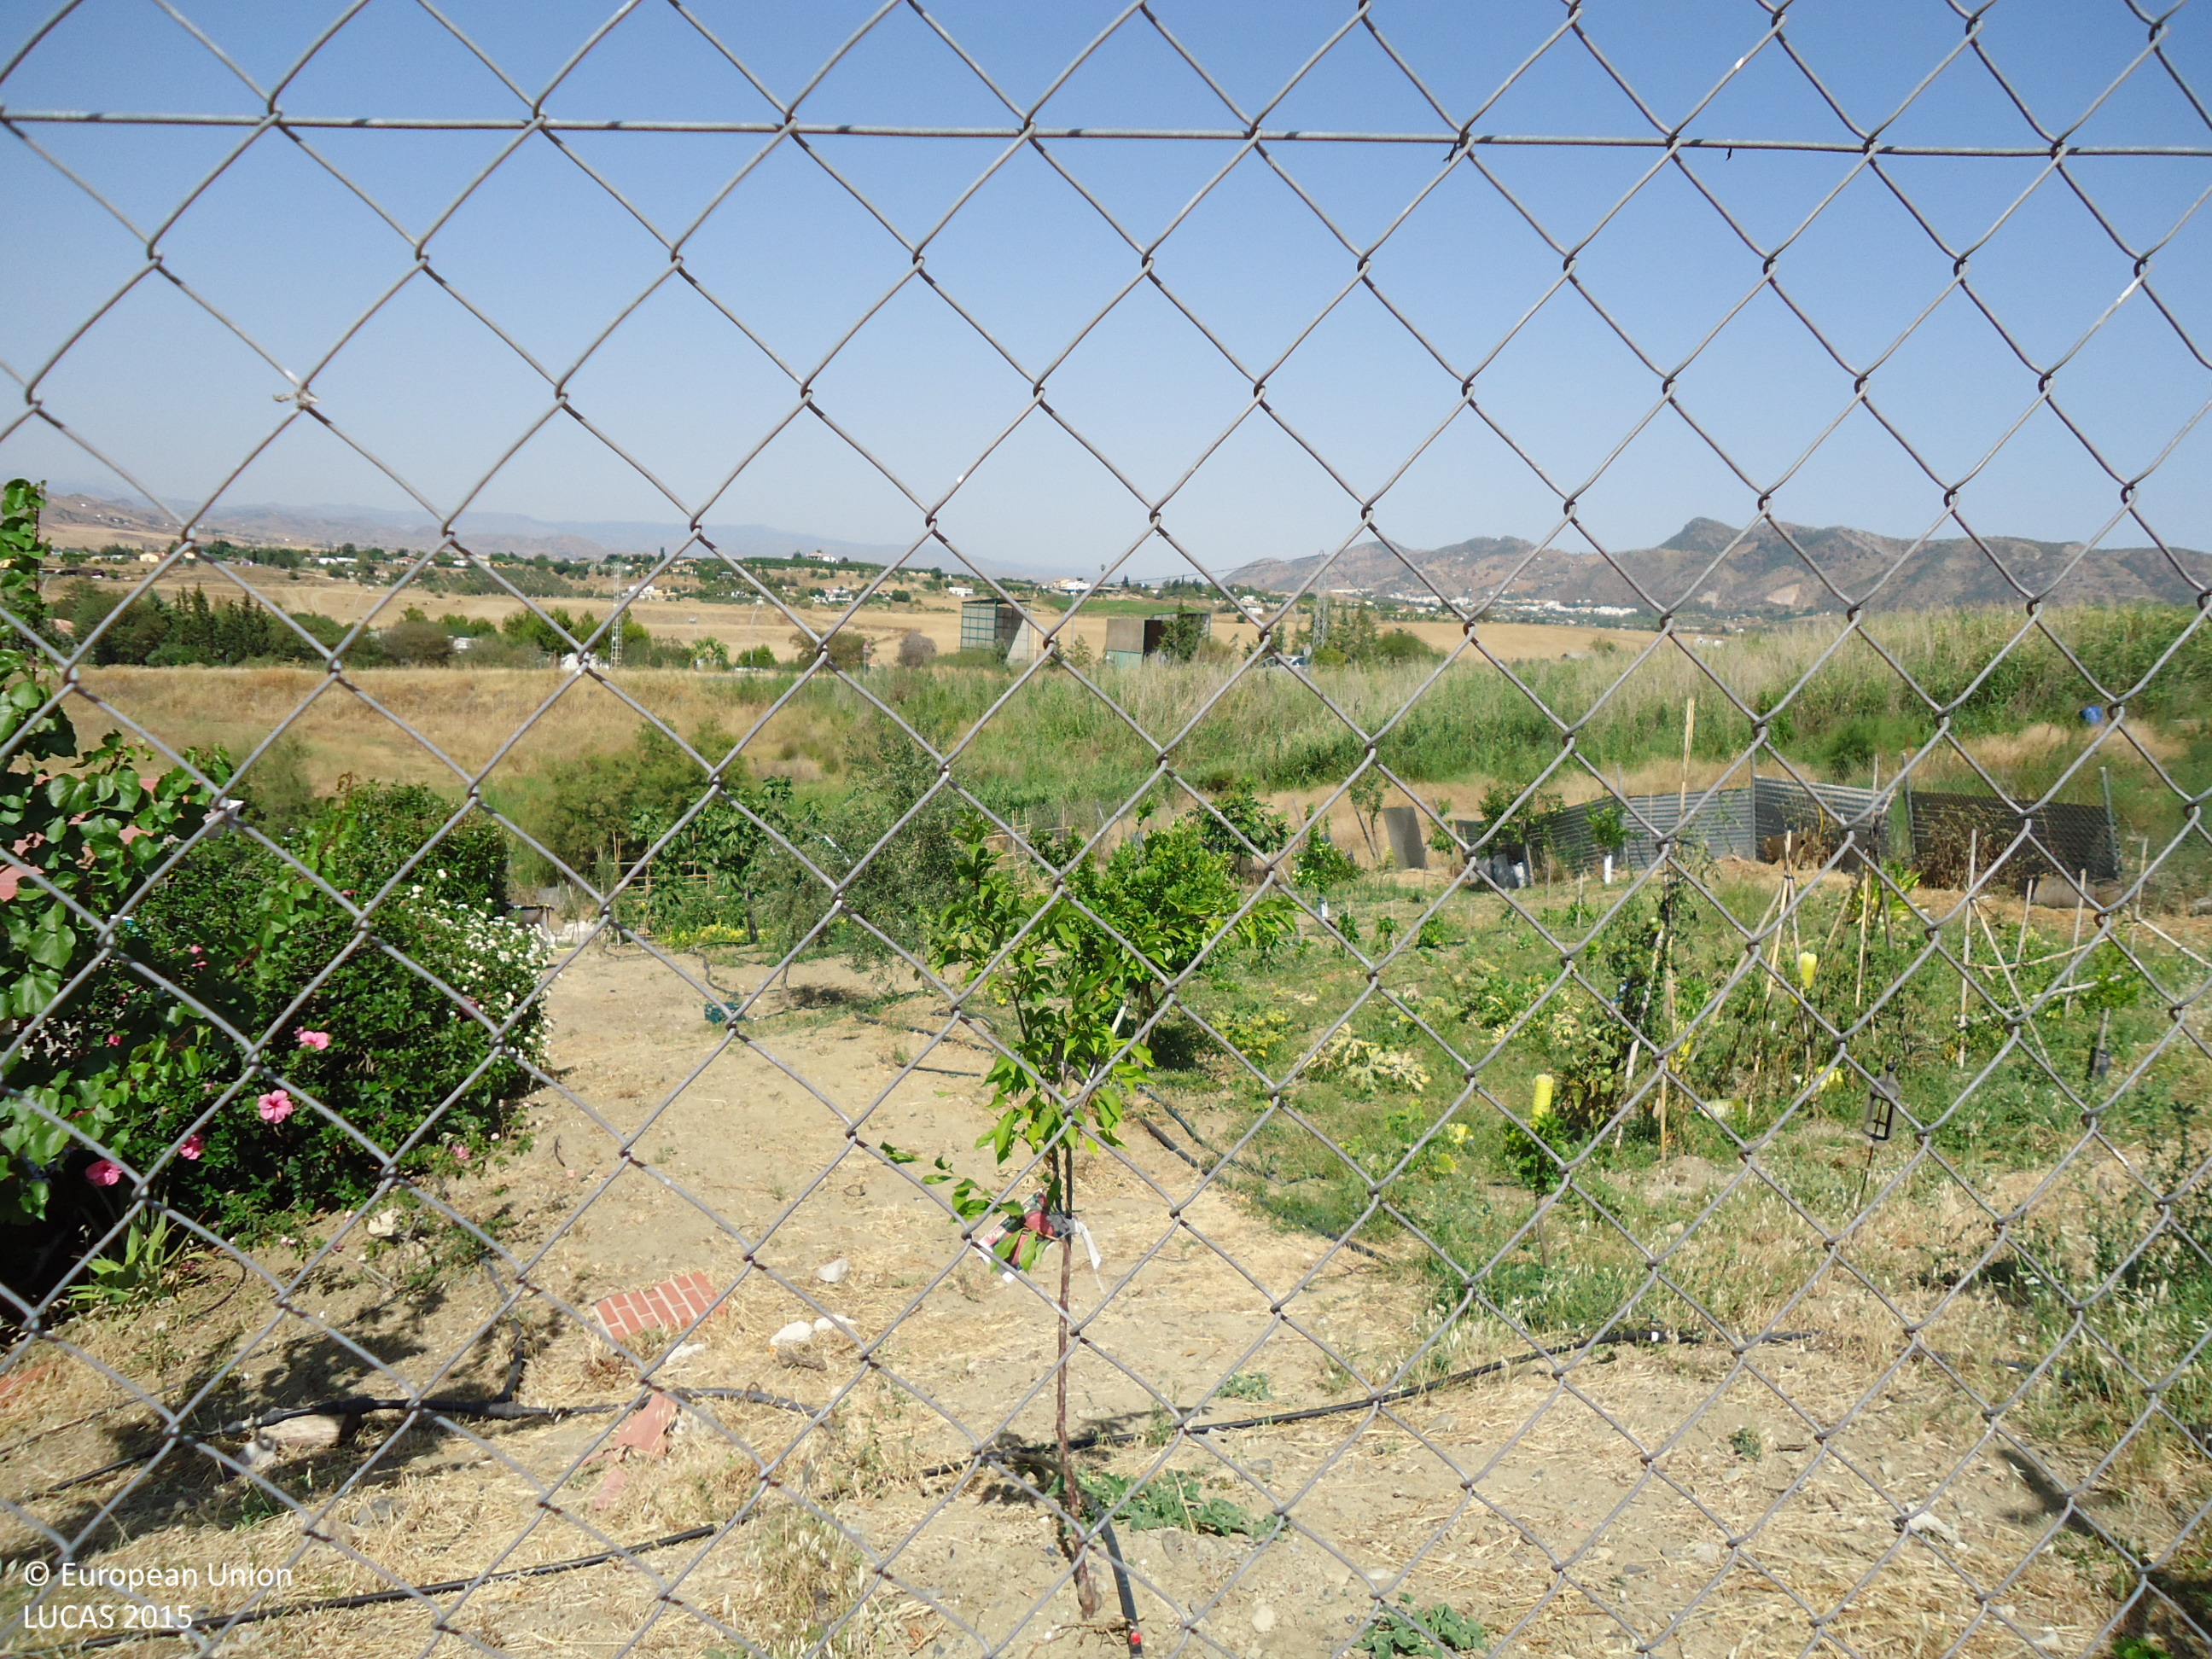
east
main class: Cropland
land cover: Other fresh vegetables
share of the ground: 25 - 50 %
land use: Kitchen garden
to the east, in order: Other fresh vegetables; Fences; Grassland without tree/shrub cover; Fences; Broadleaved woodland; Paved roads, cycling and walking lanes; Electric lines; Grassland without tree/shrub cover; Abandoned hedges; Fences; Artificial constructions in urban areas; Fences; Abandoned hedges; Grassland without tree/shrub cover; Tracks; Grassland without tree/shrub cover; Fences; Grass margins; Tracks; Electric lines; Fences; Artificial constructions in urban areas
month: June
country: ES
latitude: 36.7102
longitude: -4.6913
